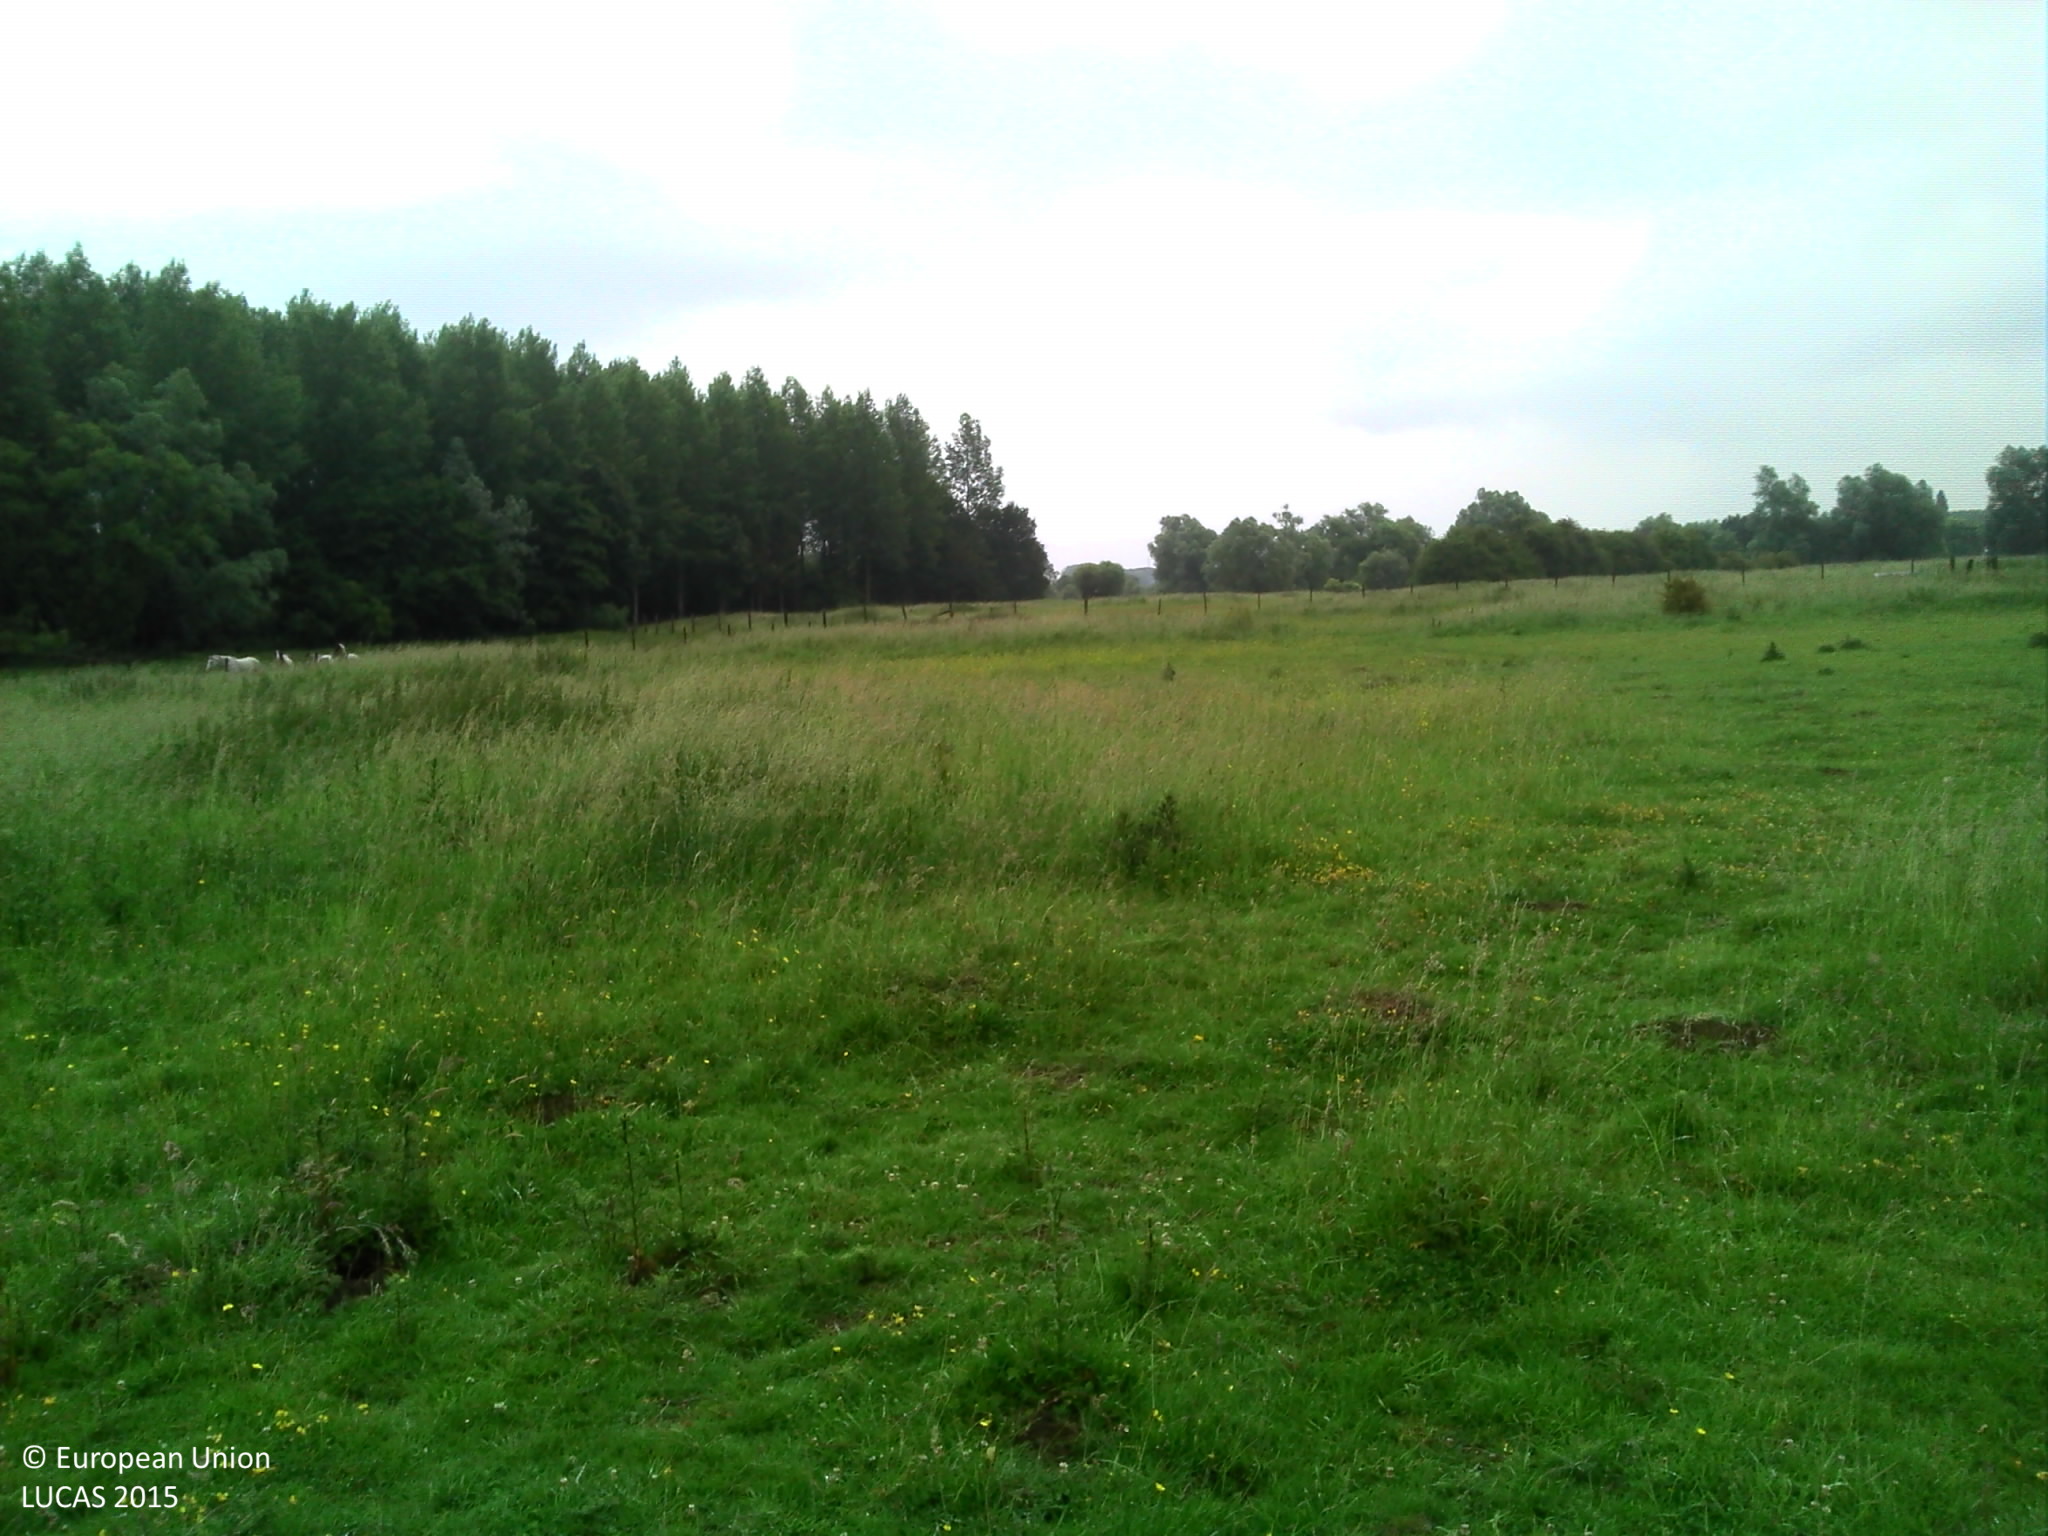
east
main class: Grassland
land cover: Grassland without tree/shrub cover
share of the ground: > 75 %
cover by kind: herbaceous plants 100 %
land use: Agriculture (excluding fallow land and kitchen gardens)
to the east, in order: Grassland without tree/shrub cover; Fences; Grassland without tree/shrub cover; Fences; Grass margins; Fences; Grassland without tree/shrub cover
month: June
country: BE
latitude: 50.4428
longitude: 3.6988
